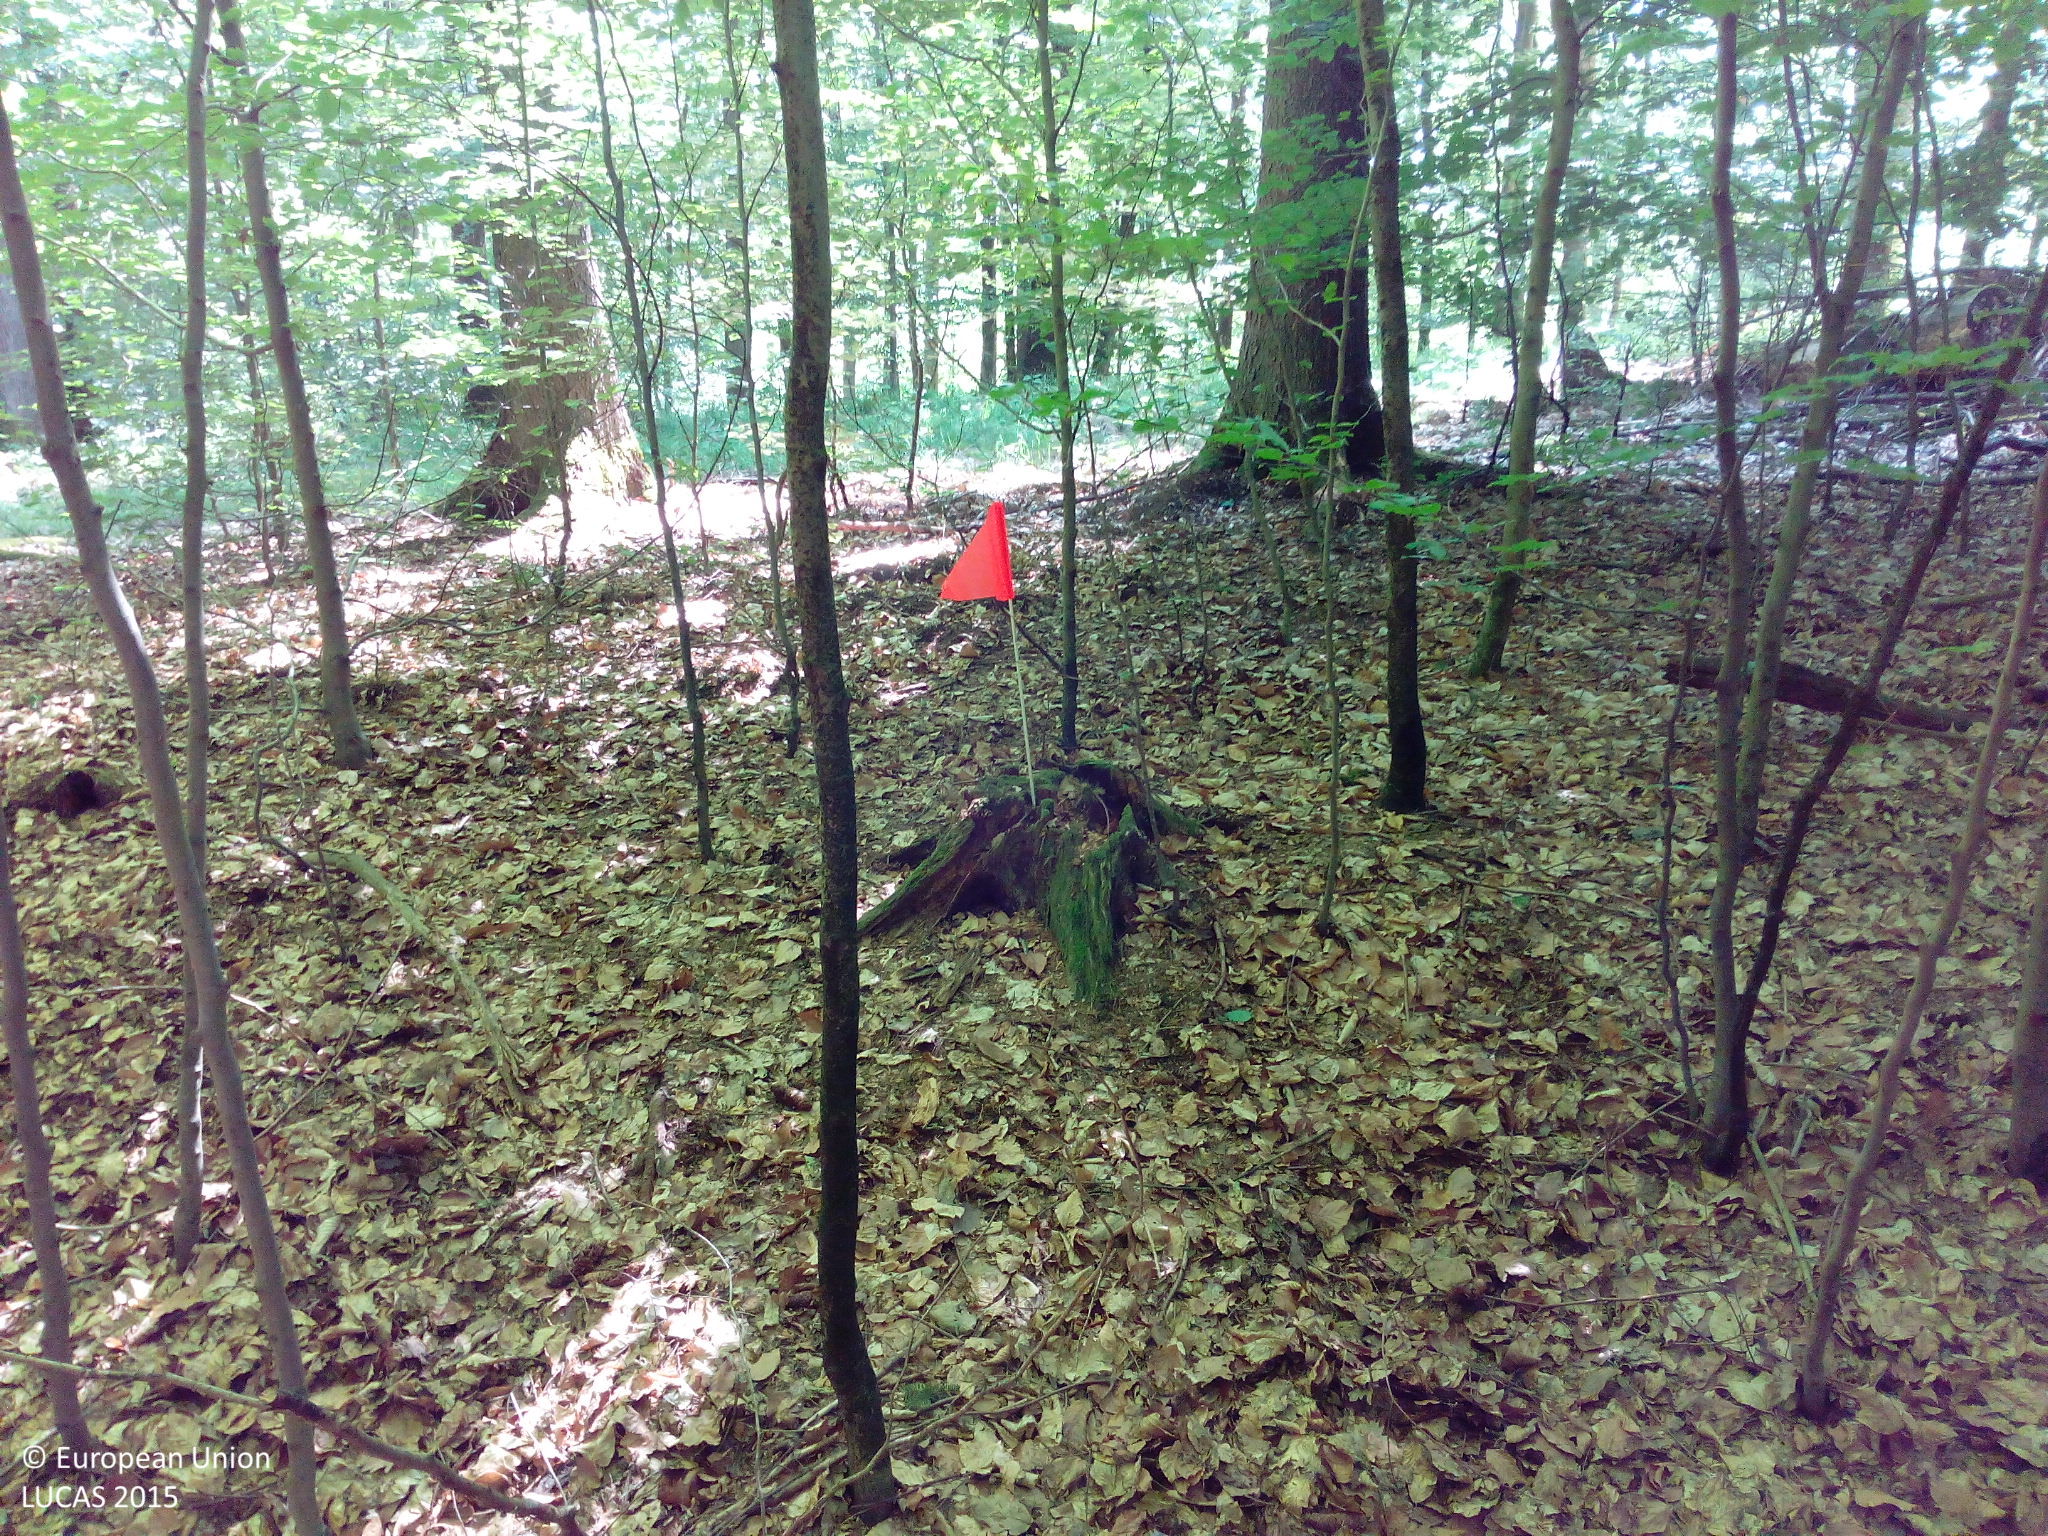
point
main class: Woodland
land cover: Spruce dominated mixed woodland
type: hemiboreal forest and nemoral coniferous forest and mixed broadleaved-coniferous forest
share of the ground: > 75 %
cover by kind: coniferous forest trees 60 %, broadleaved forest trees 40 %
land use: Forestry
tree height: > 5 m
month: June
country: DE
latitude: 49.1574
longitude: 9.3832
